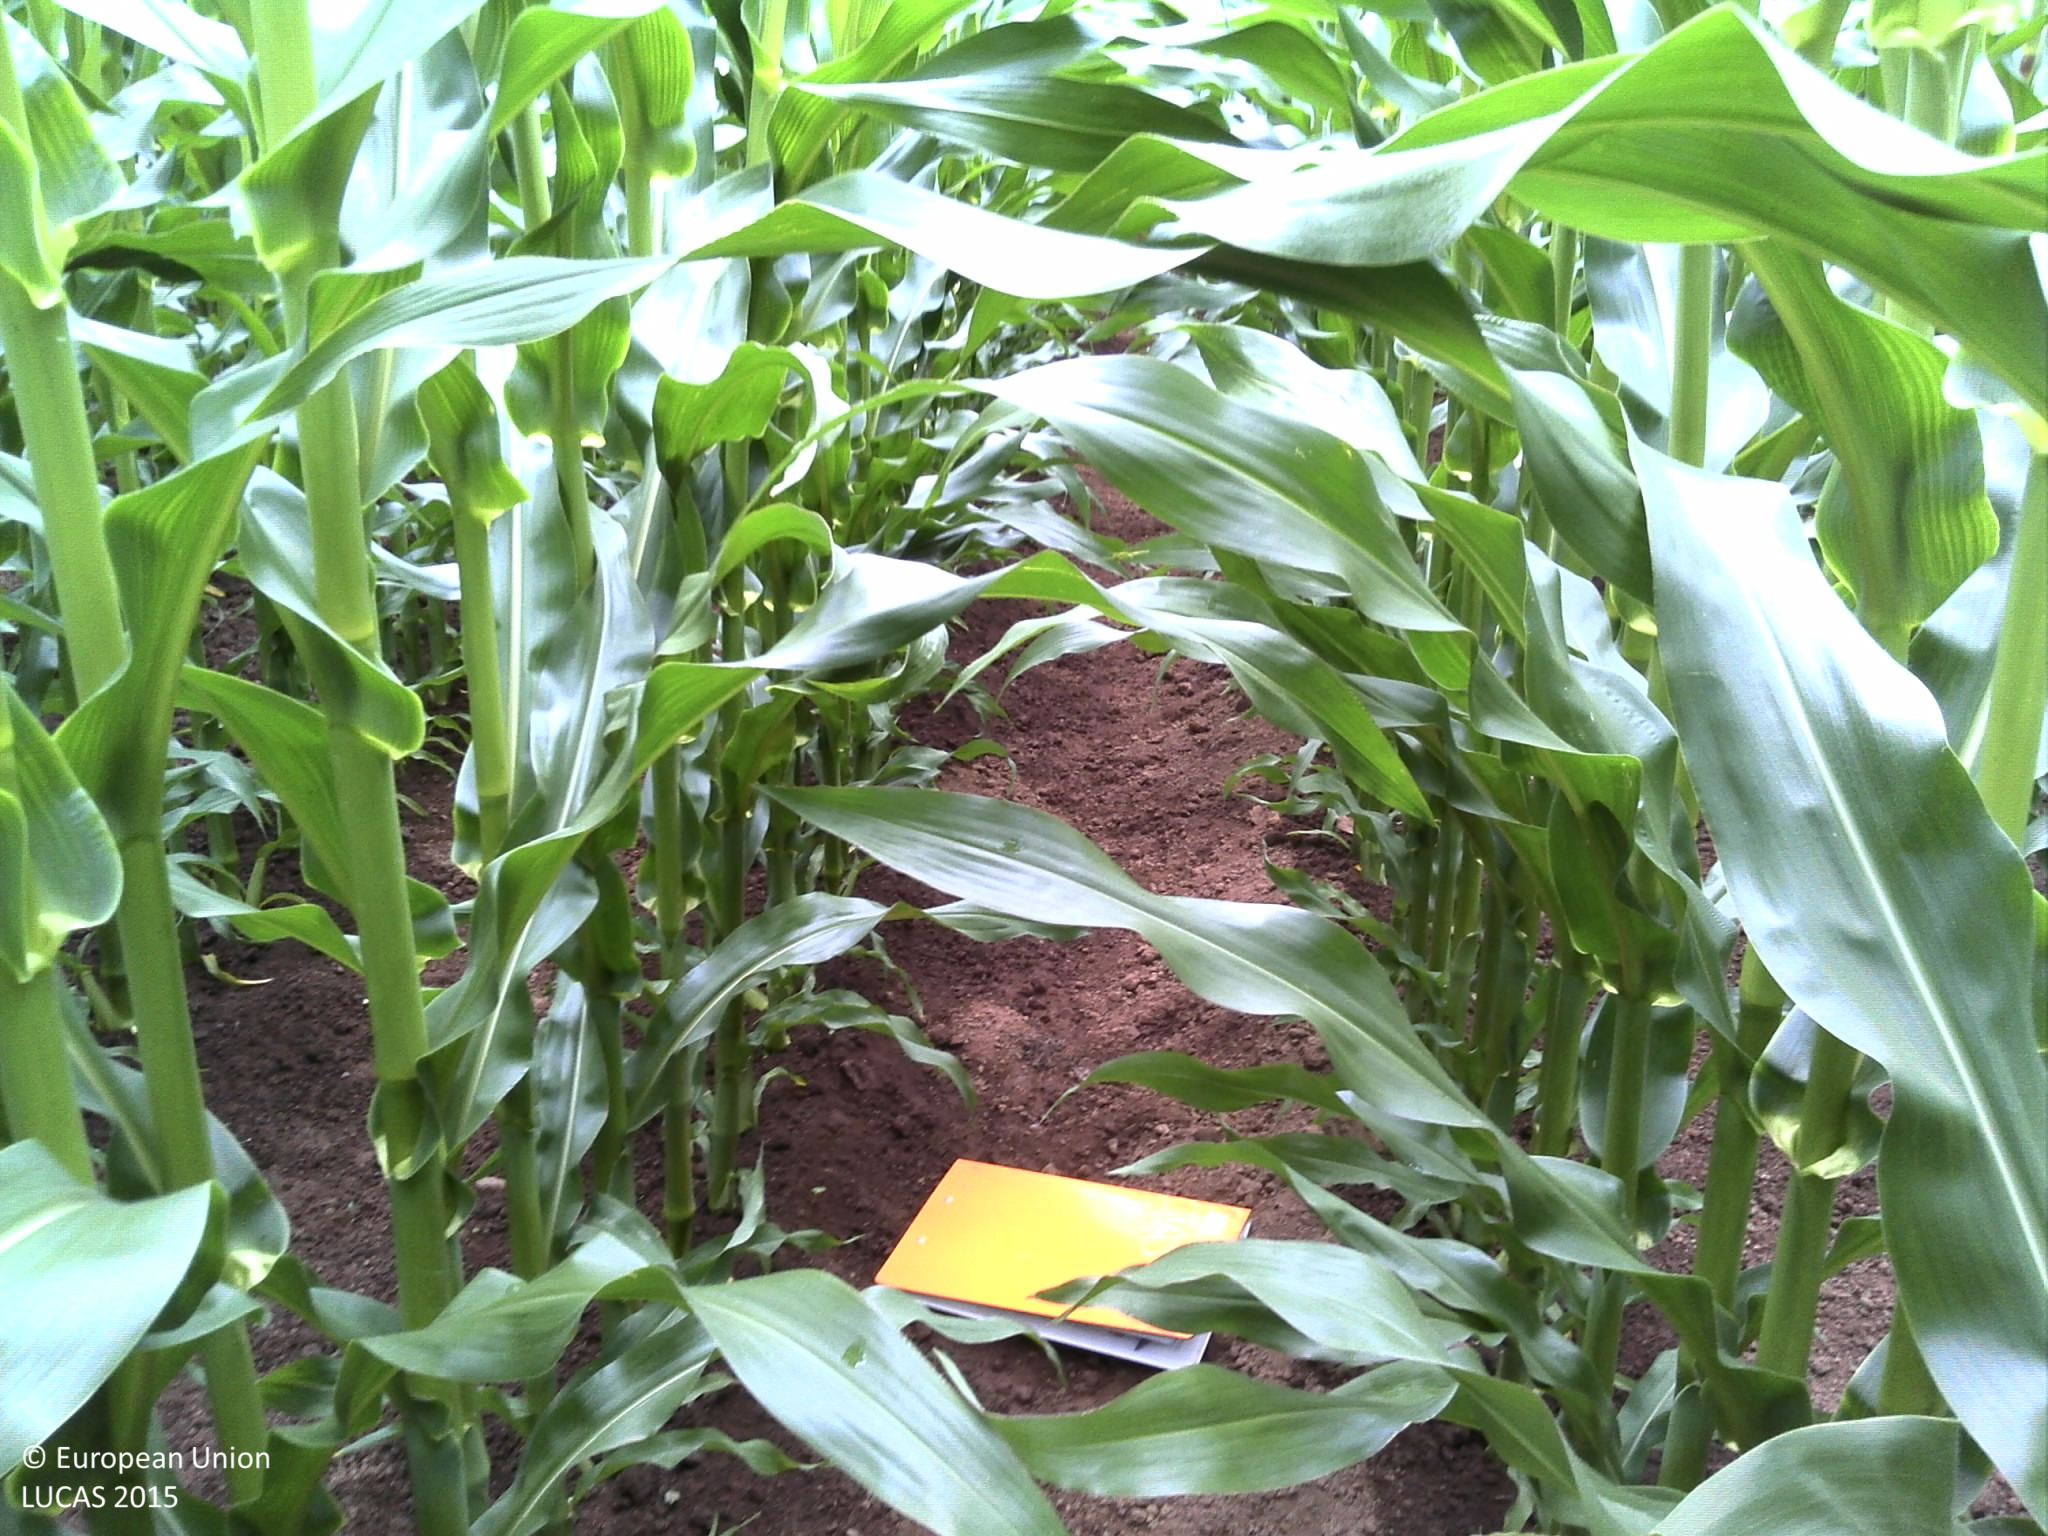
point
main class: Cropland
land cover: Maize
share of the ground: > 75 %
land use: Agriculture (excluding fallow land and kitchen gardens)
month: July
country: FR
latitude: 48.4610
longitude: -4.5289
